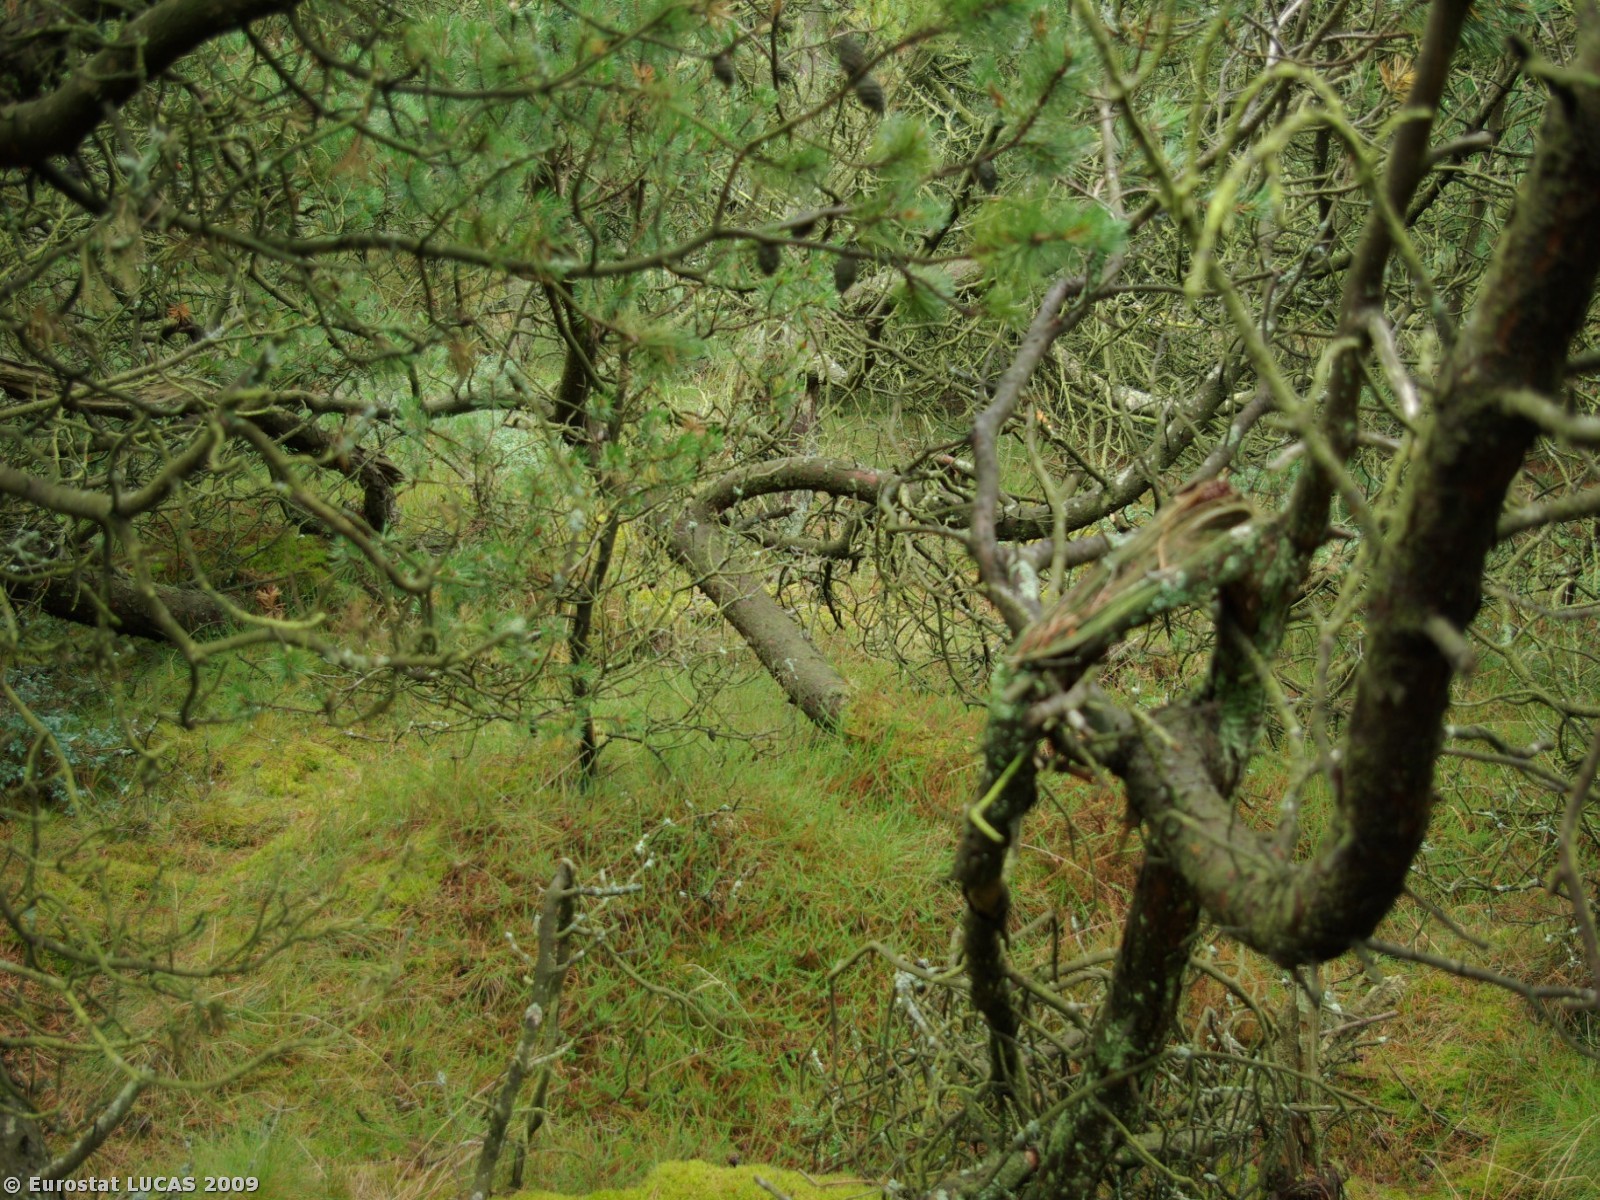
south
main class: Woodland
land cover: Coniferous woodland
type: hemiboreal forest and nemoral coniferous forest and mixed broadleaved-coniferous forest
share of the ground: > 75 %
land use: Unused
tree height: > 5 m
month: July
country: DK
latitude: 55.1188
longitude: 8.5429
